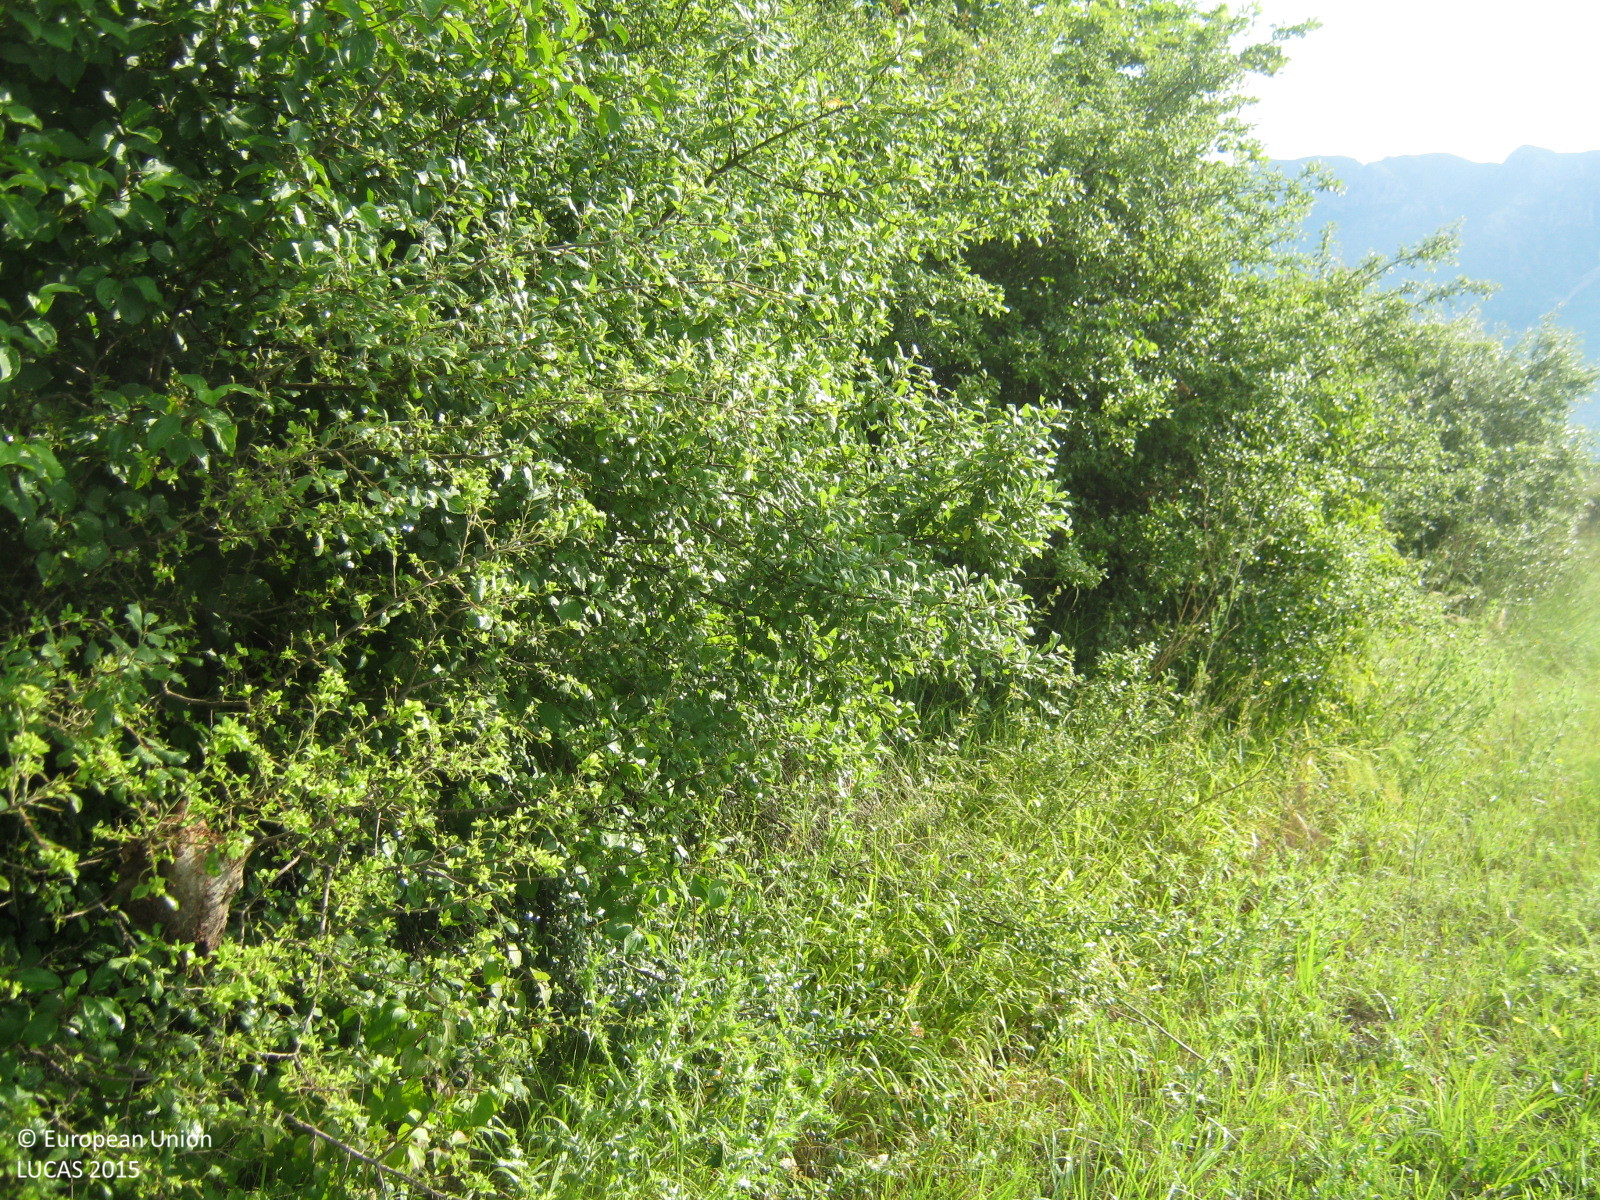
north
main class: Cropland
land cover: Lucerne
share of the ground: > 75 %
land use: Agriculture (excluding fallow land and kitchen gardens)
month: June
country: GR
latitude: 39.3892
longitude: 20.5279
